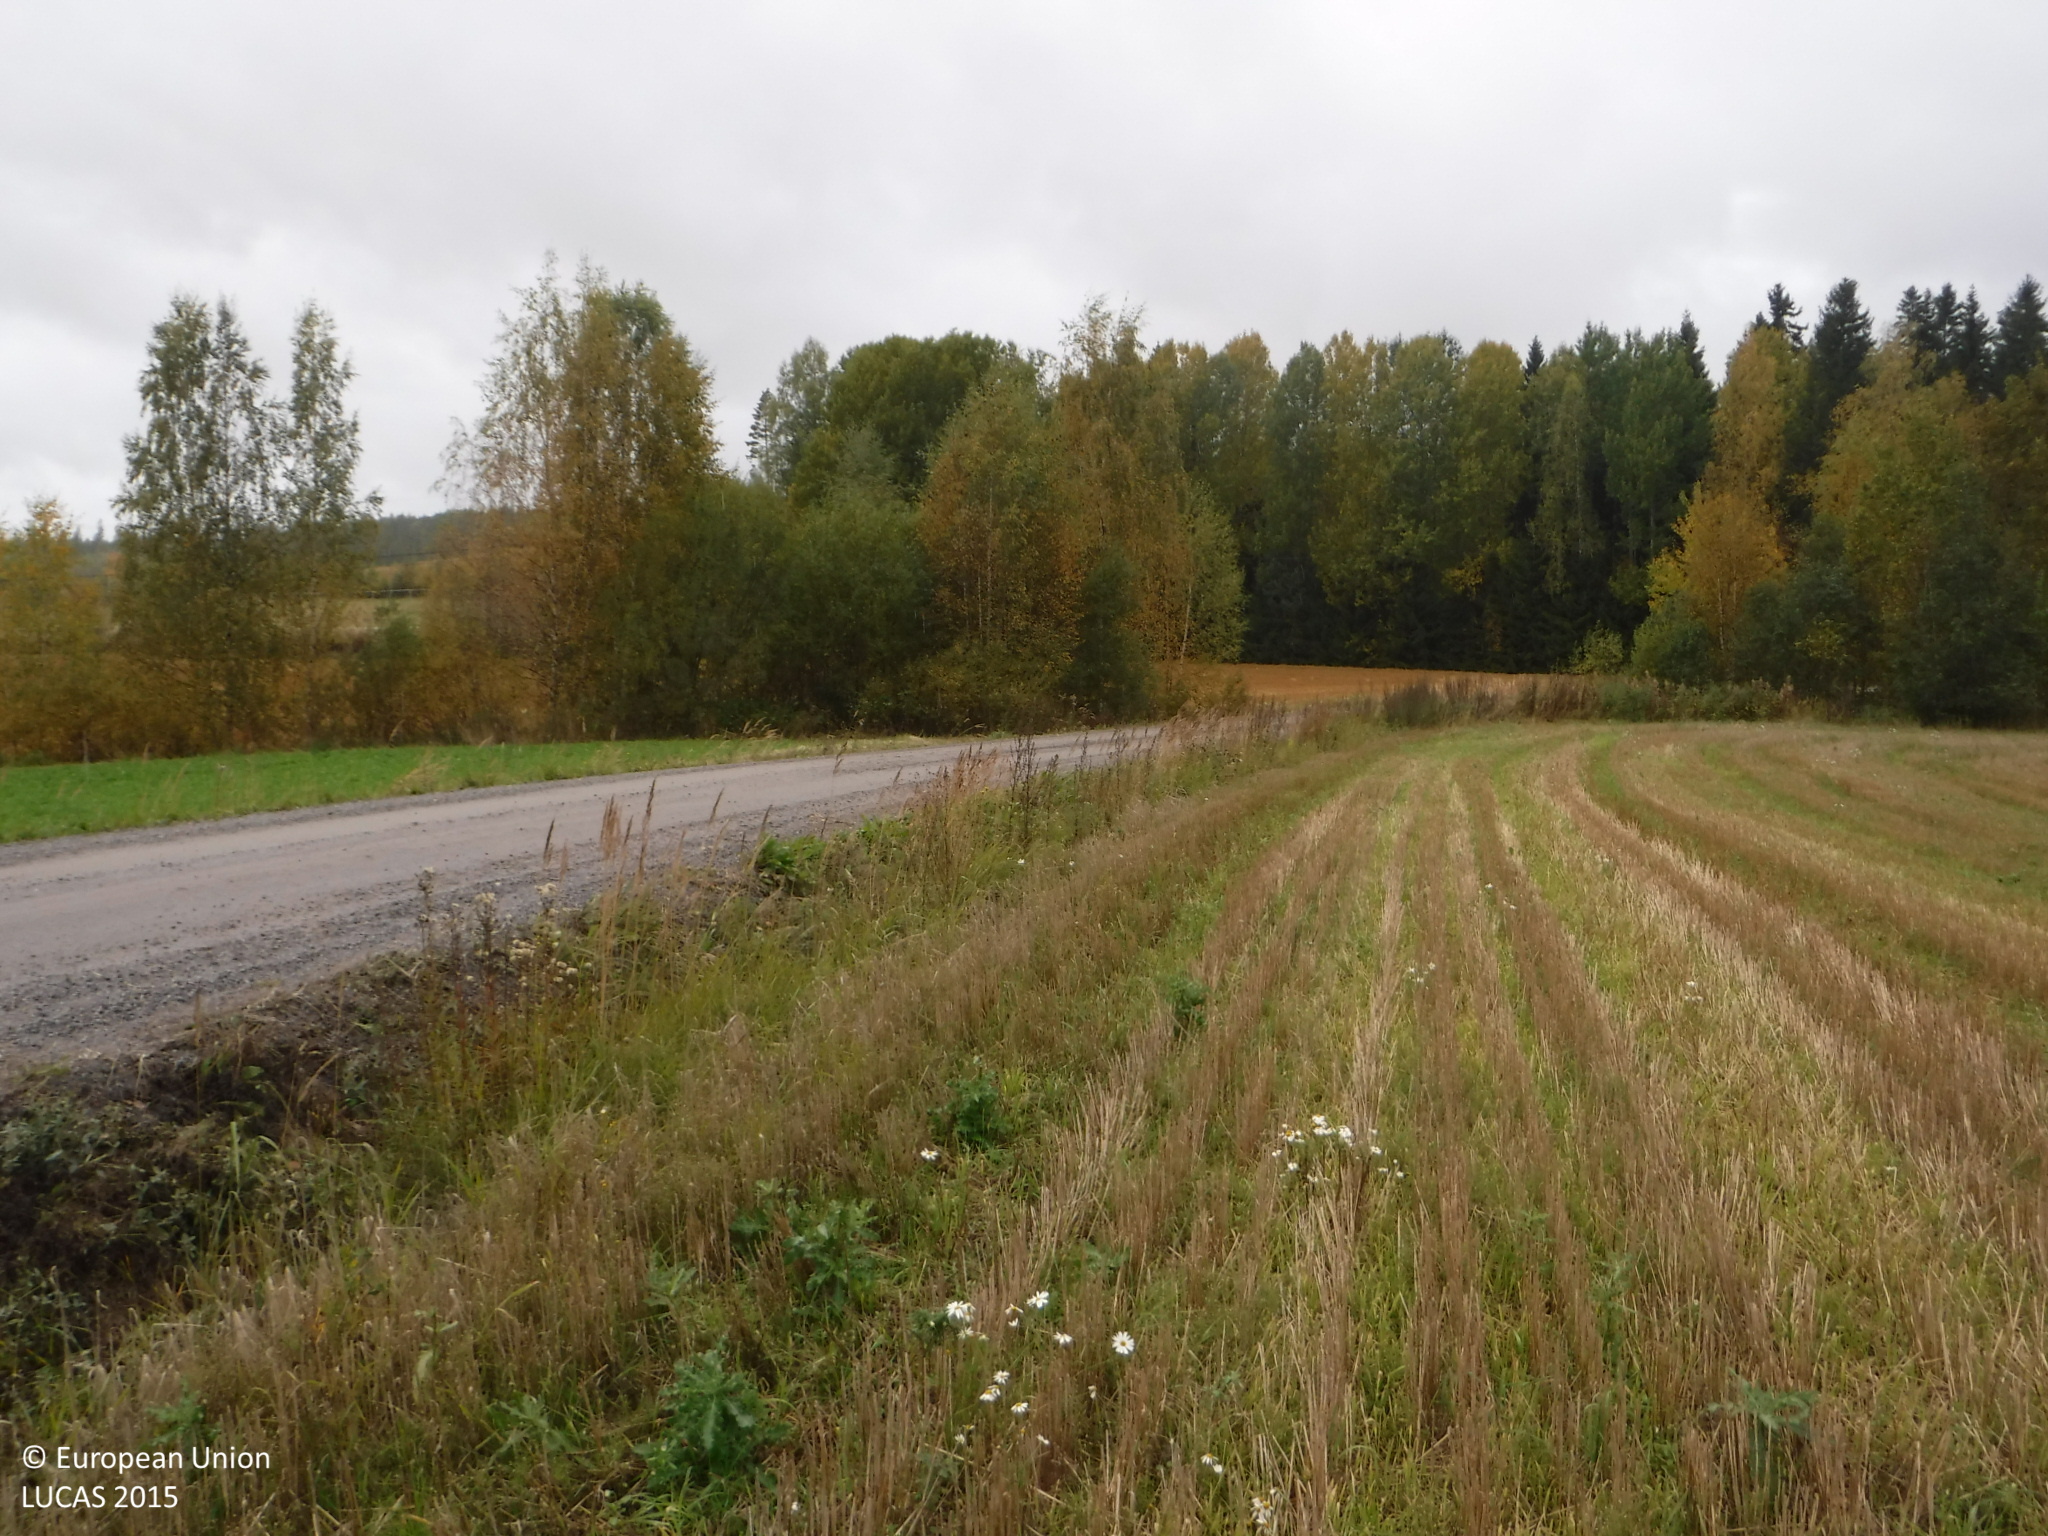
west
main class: Cropland
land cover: Barley
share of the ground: > 75 %
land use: Agriculture (excluding fallow land and kitchen gardens)
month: September
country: FI
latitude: 61.5848
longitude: 24.3937
